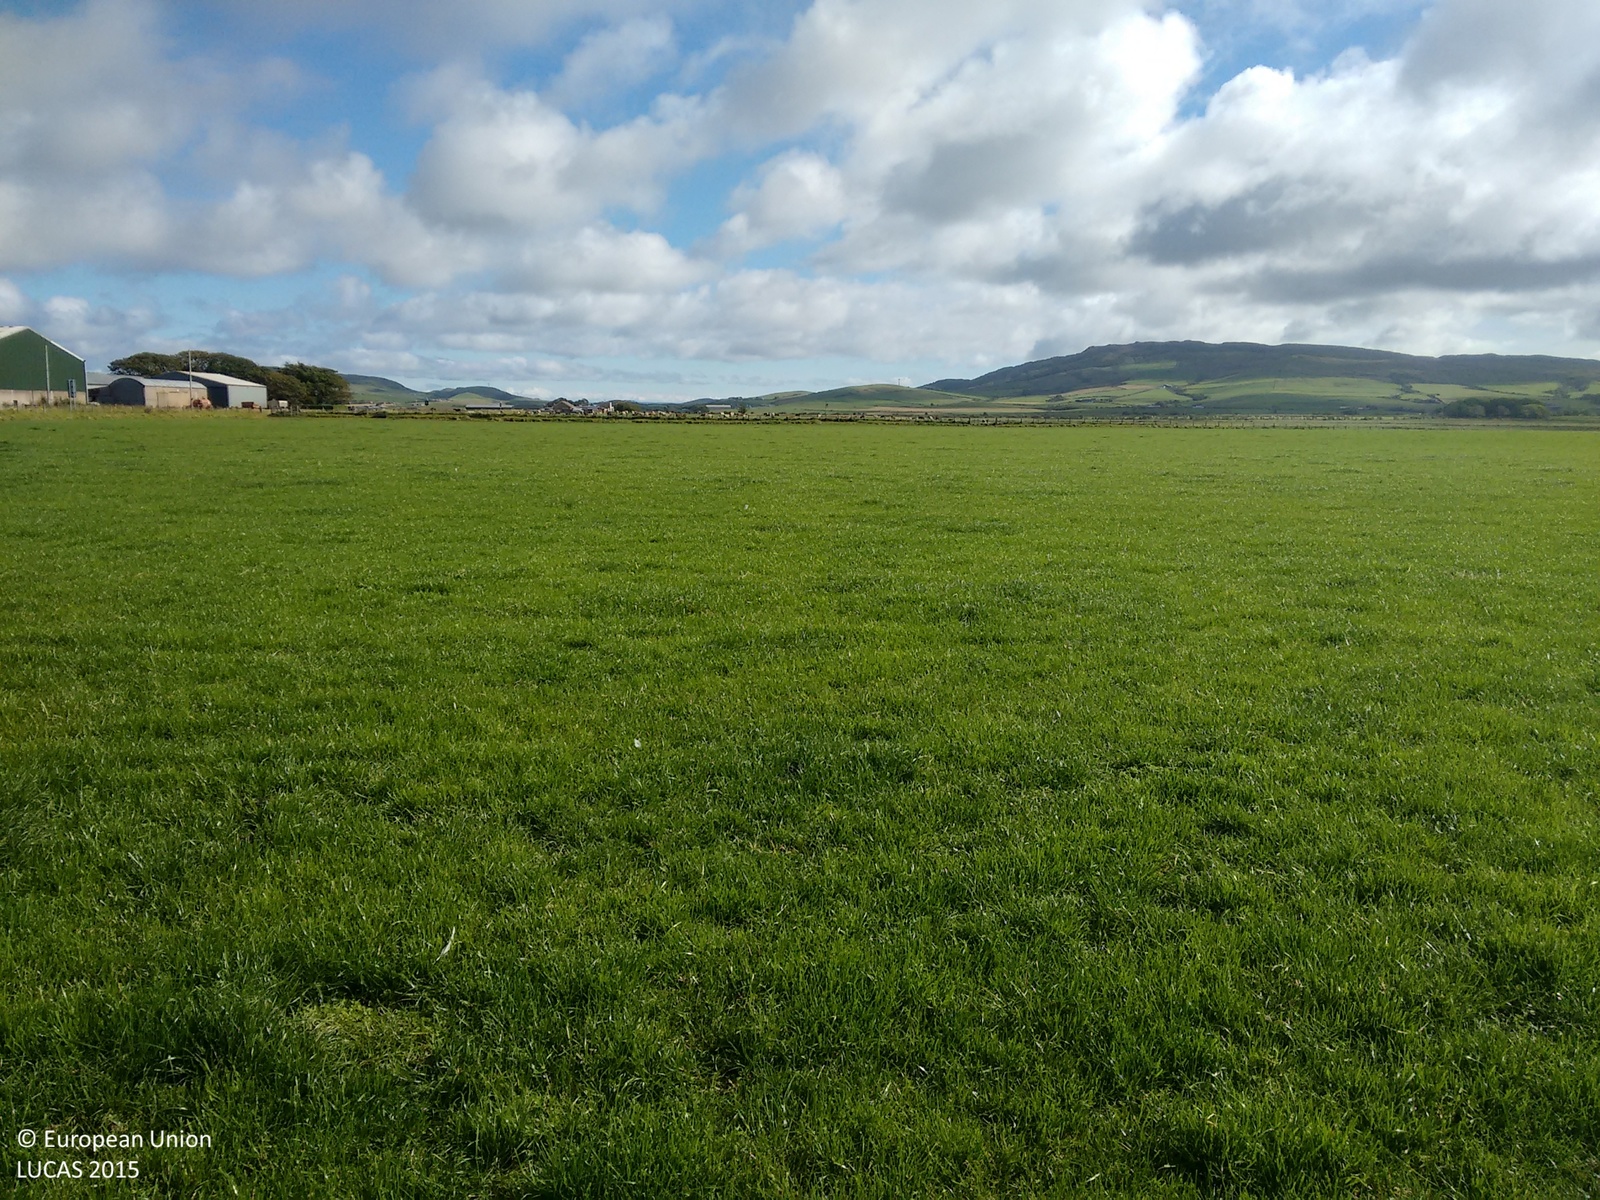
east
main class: Grassland
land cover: Grassland without tree/shrub cover
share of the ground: > 75 %
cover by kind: herbaceous plants 100 %
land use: Agriculture (excluding fallow land and kitchen gardens)
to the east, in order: Grassland without tree/shrub cover; Fences; Grass margins; Paved roads, cycling and walking lanes; Grass margins; Fences; Grassland without tree/shrub cover
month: September
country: GB
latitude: 55.4155
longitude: -5.6896
